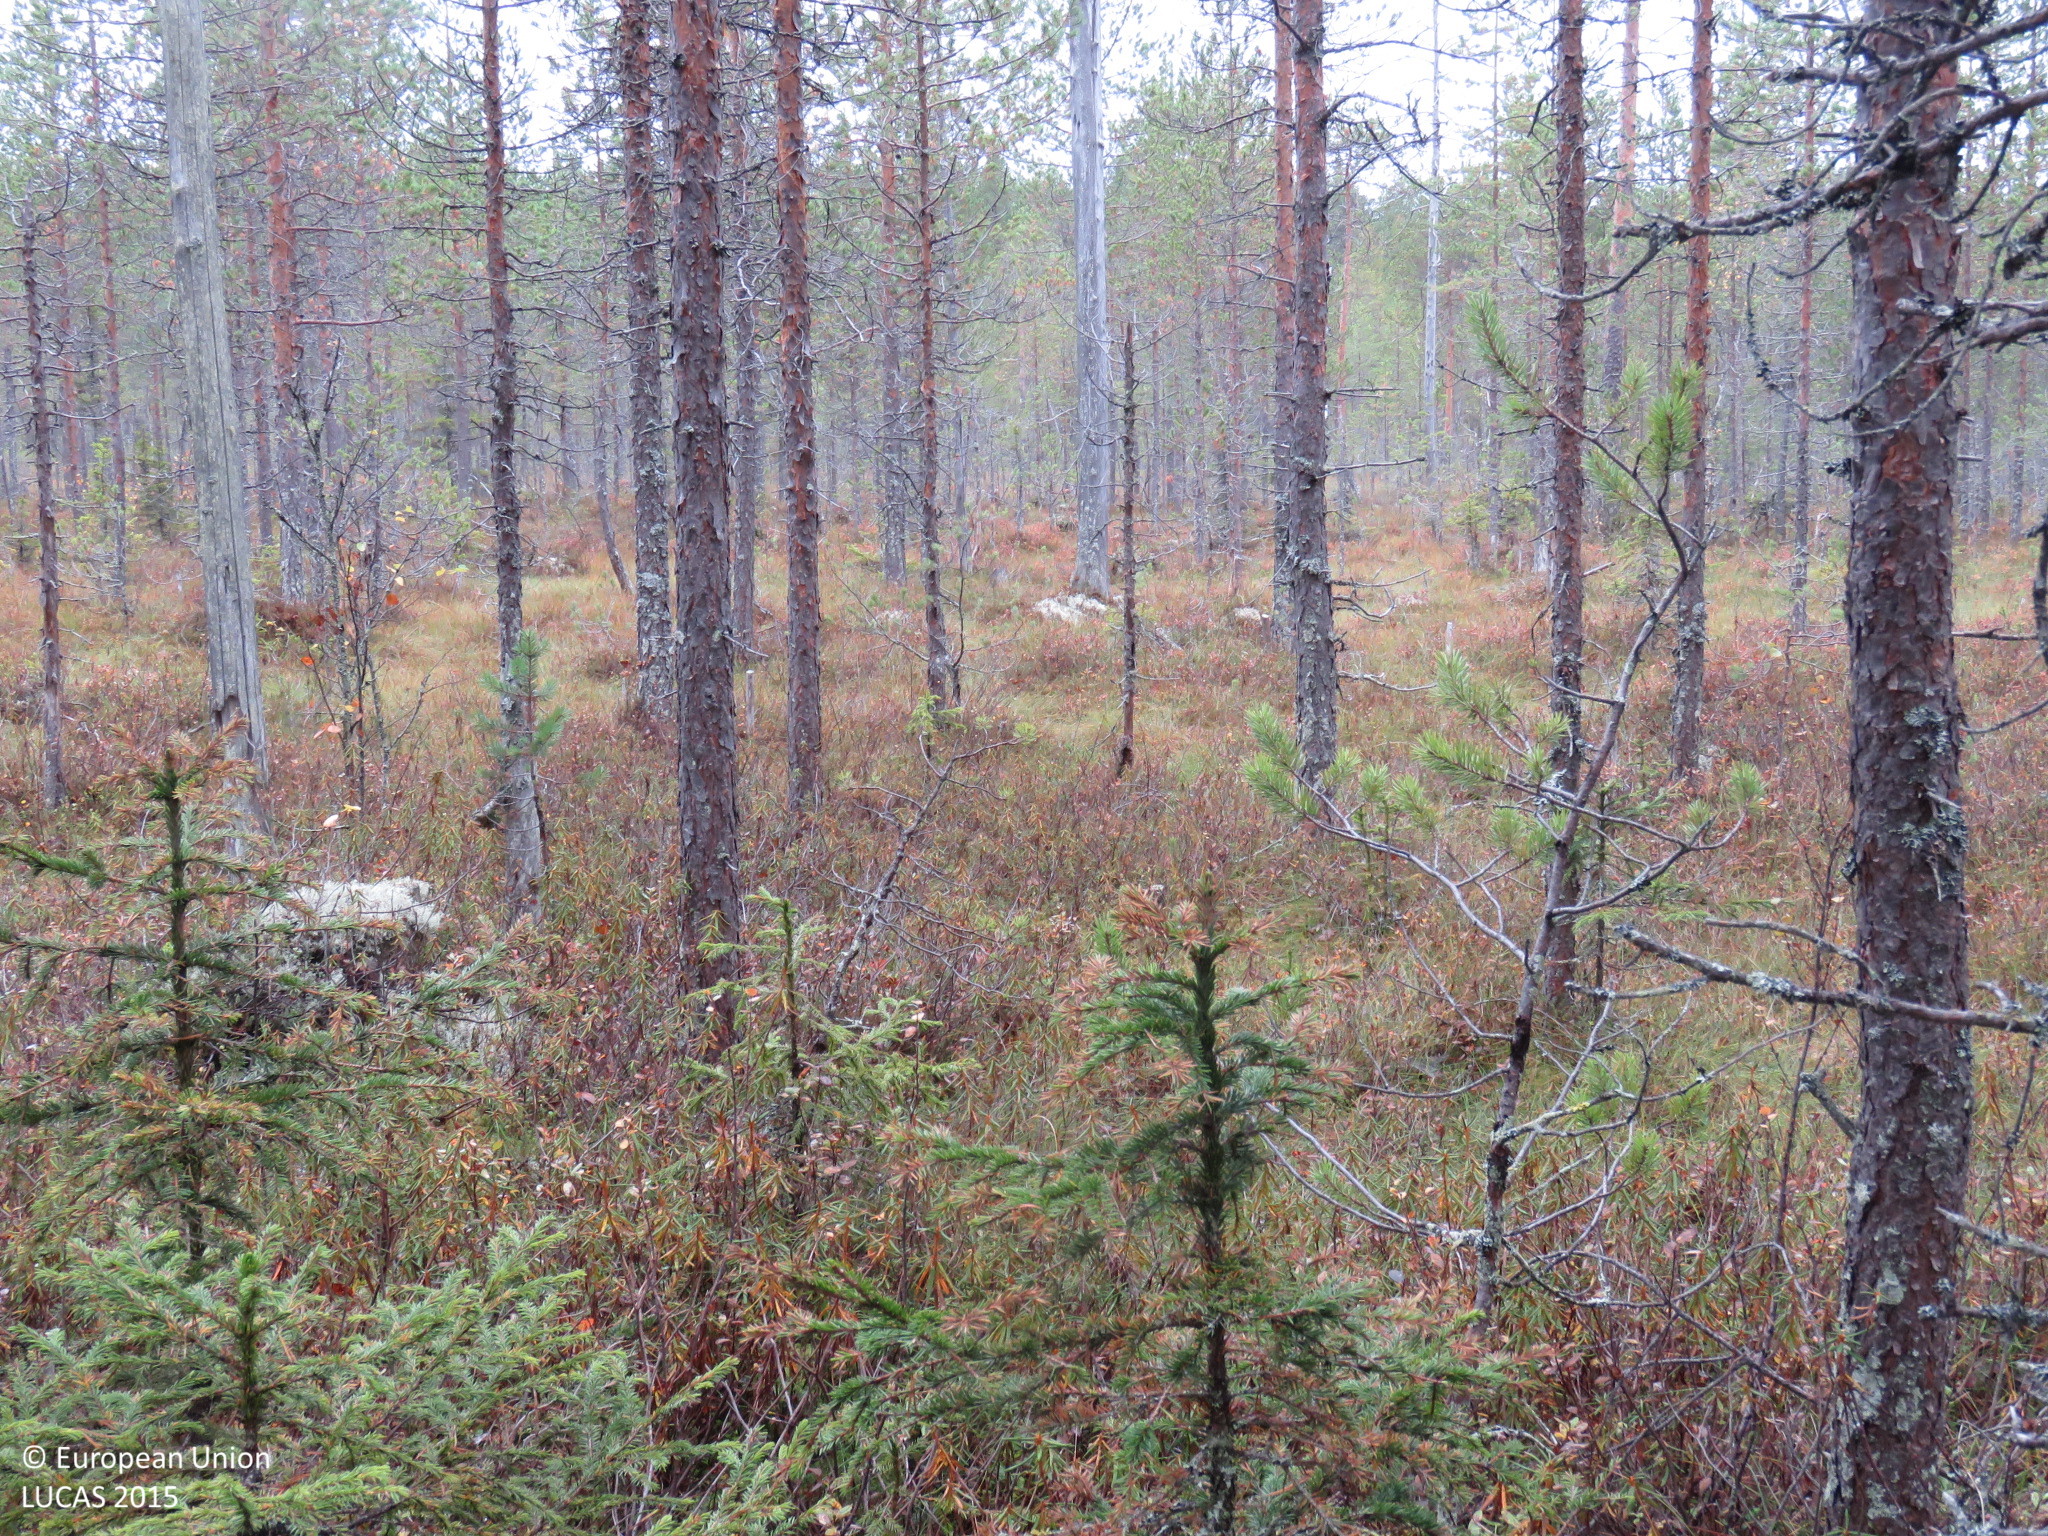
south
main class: Woodland
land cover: Other mixed woodland
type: mire and swamp forests
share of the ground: > 75 %
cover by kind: coniferous forest trees 50 %, broadleaved forest trees 25 %, shrubs 10 %, lichens and mosses 10 %, herbaceous plants 5 %
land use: Forestry
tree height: > 5 m
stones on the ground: < 10 %
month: September
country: FI
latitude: 64.8395
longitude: 27.0529
